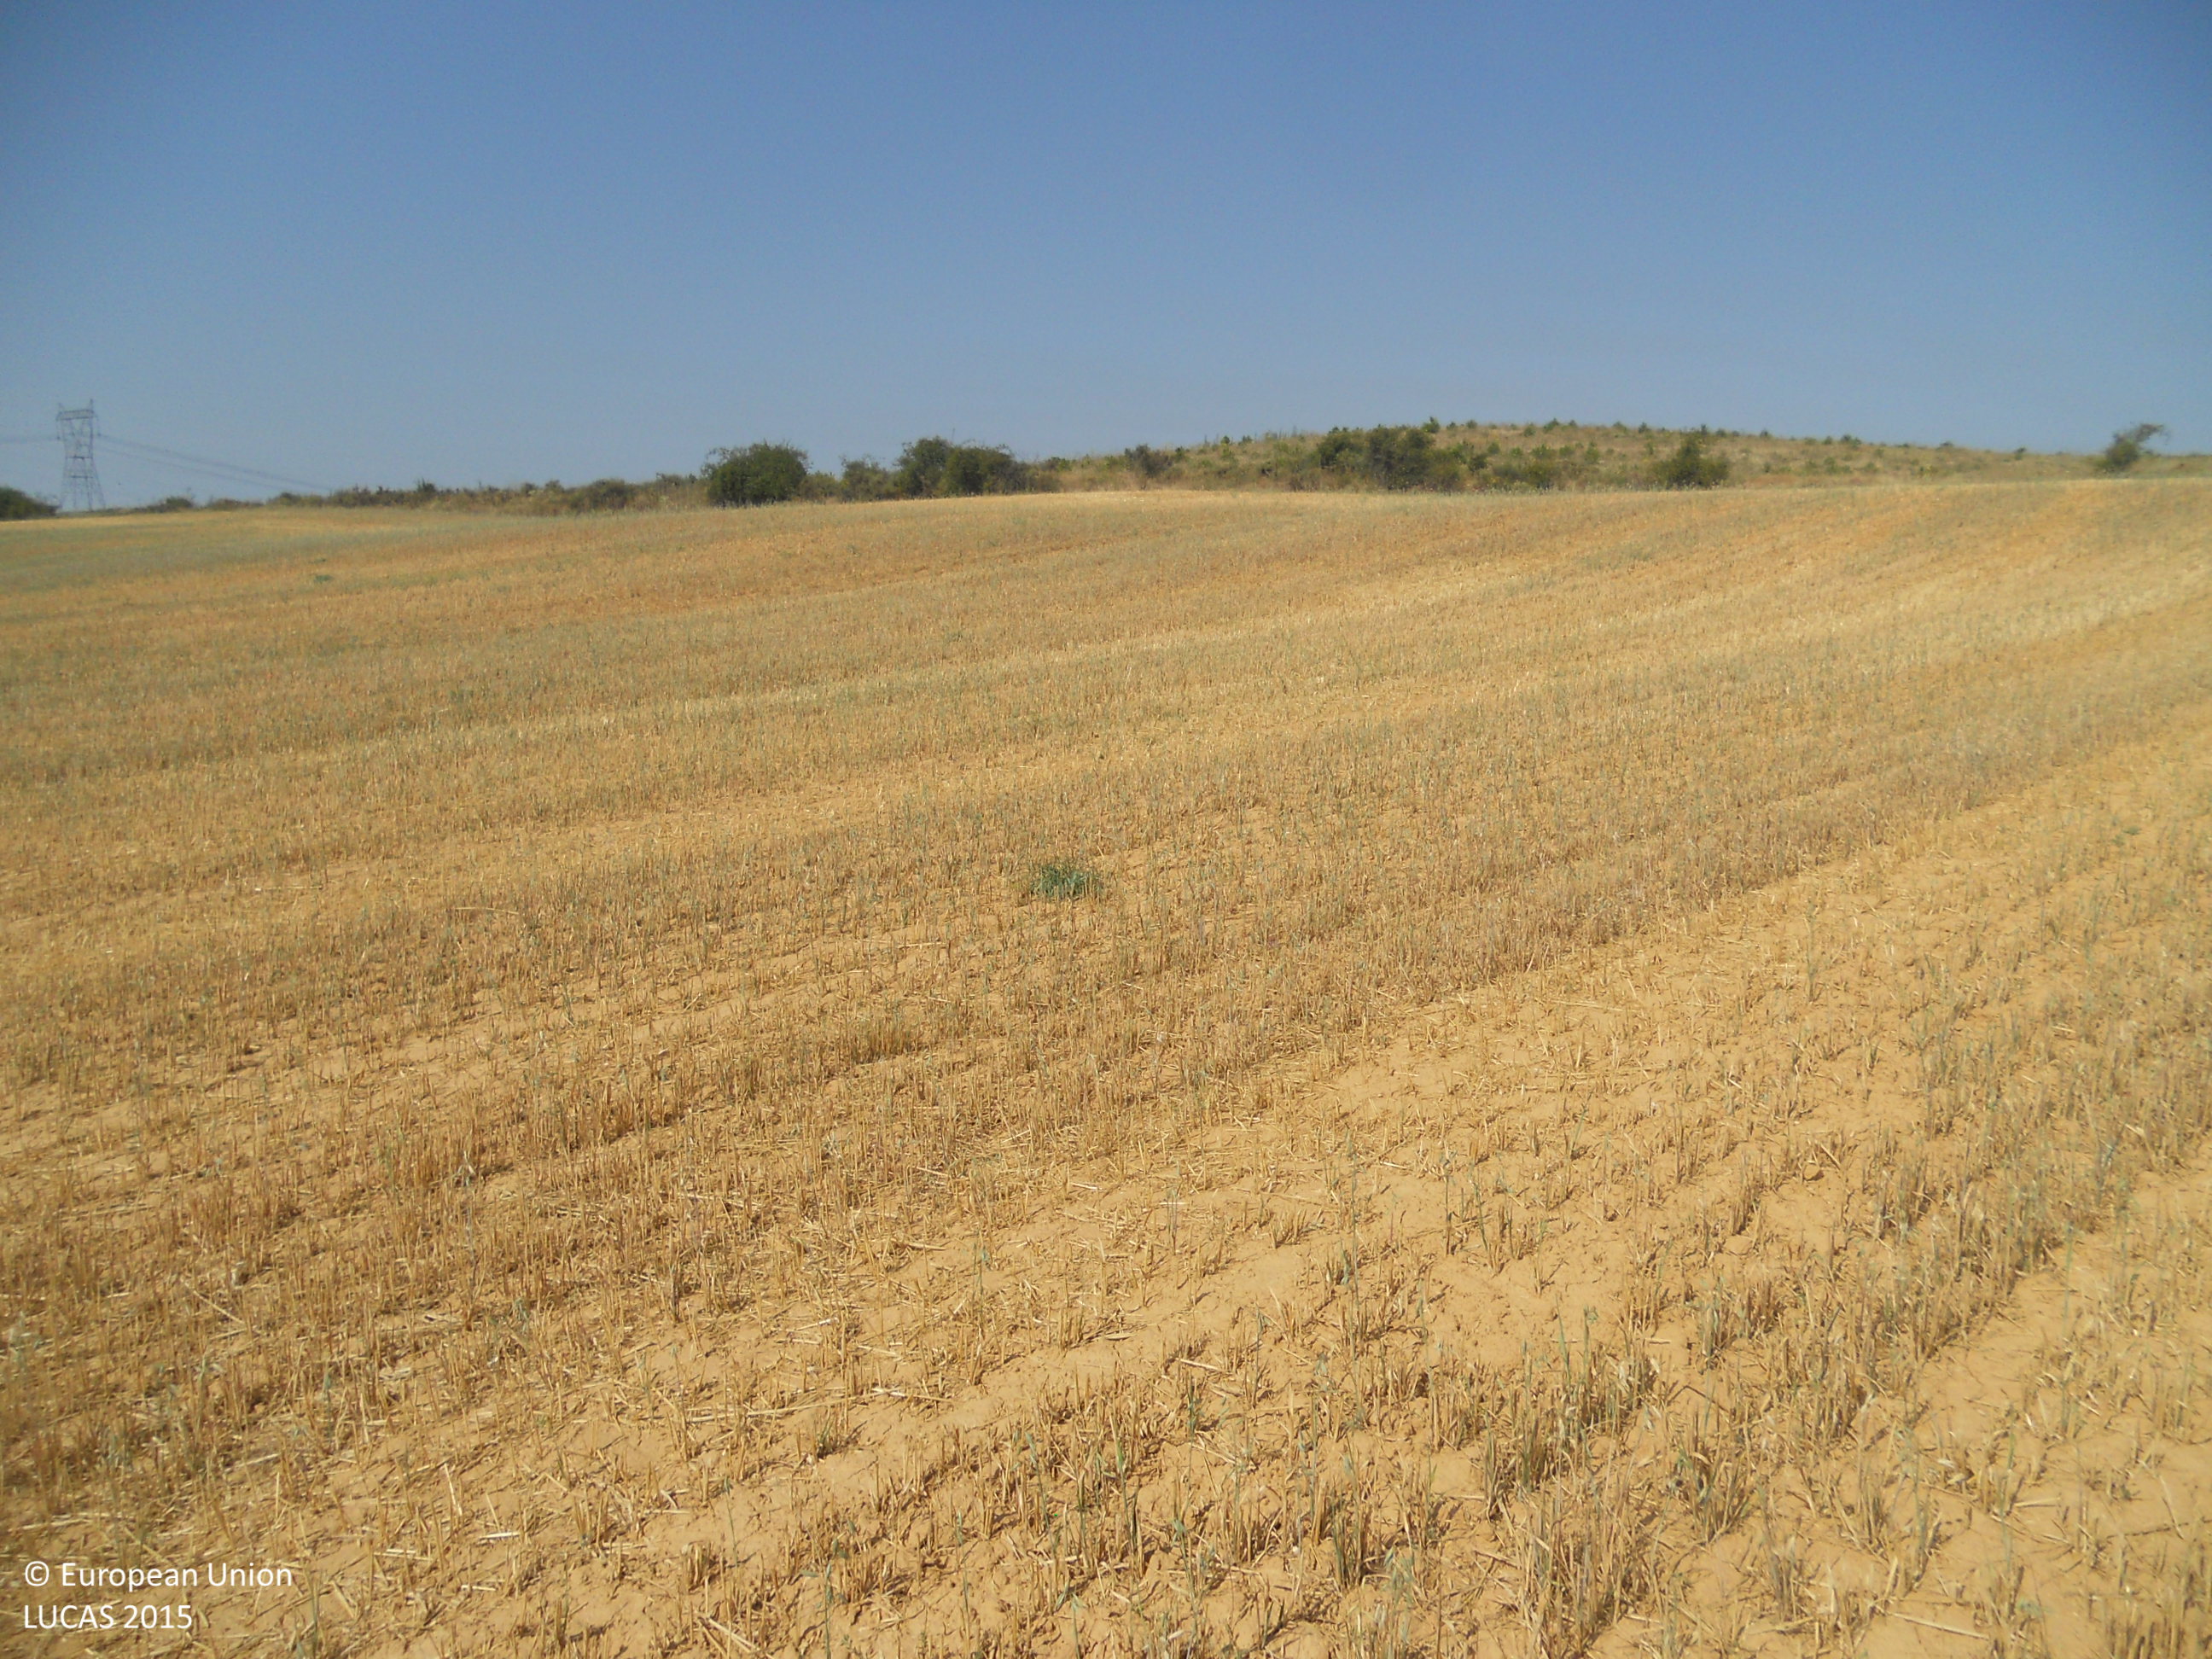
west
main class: Cropland
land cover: Oats
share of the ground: < 10 %
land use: Agriculture (excluding fallow land and kitchen gardens)
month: July
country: ES
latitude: 42.5616
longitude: -5.3295
